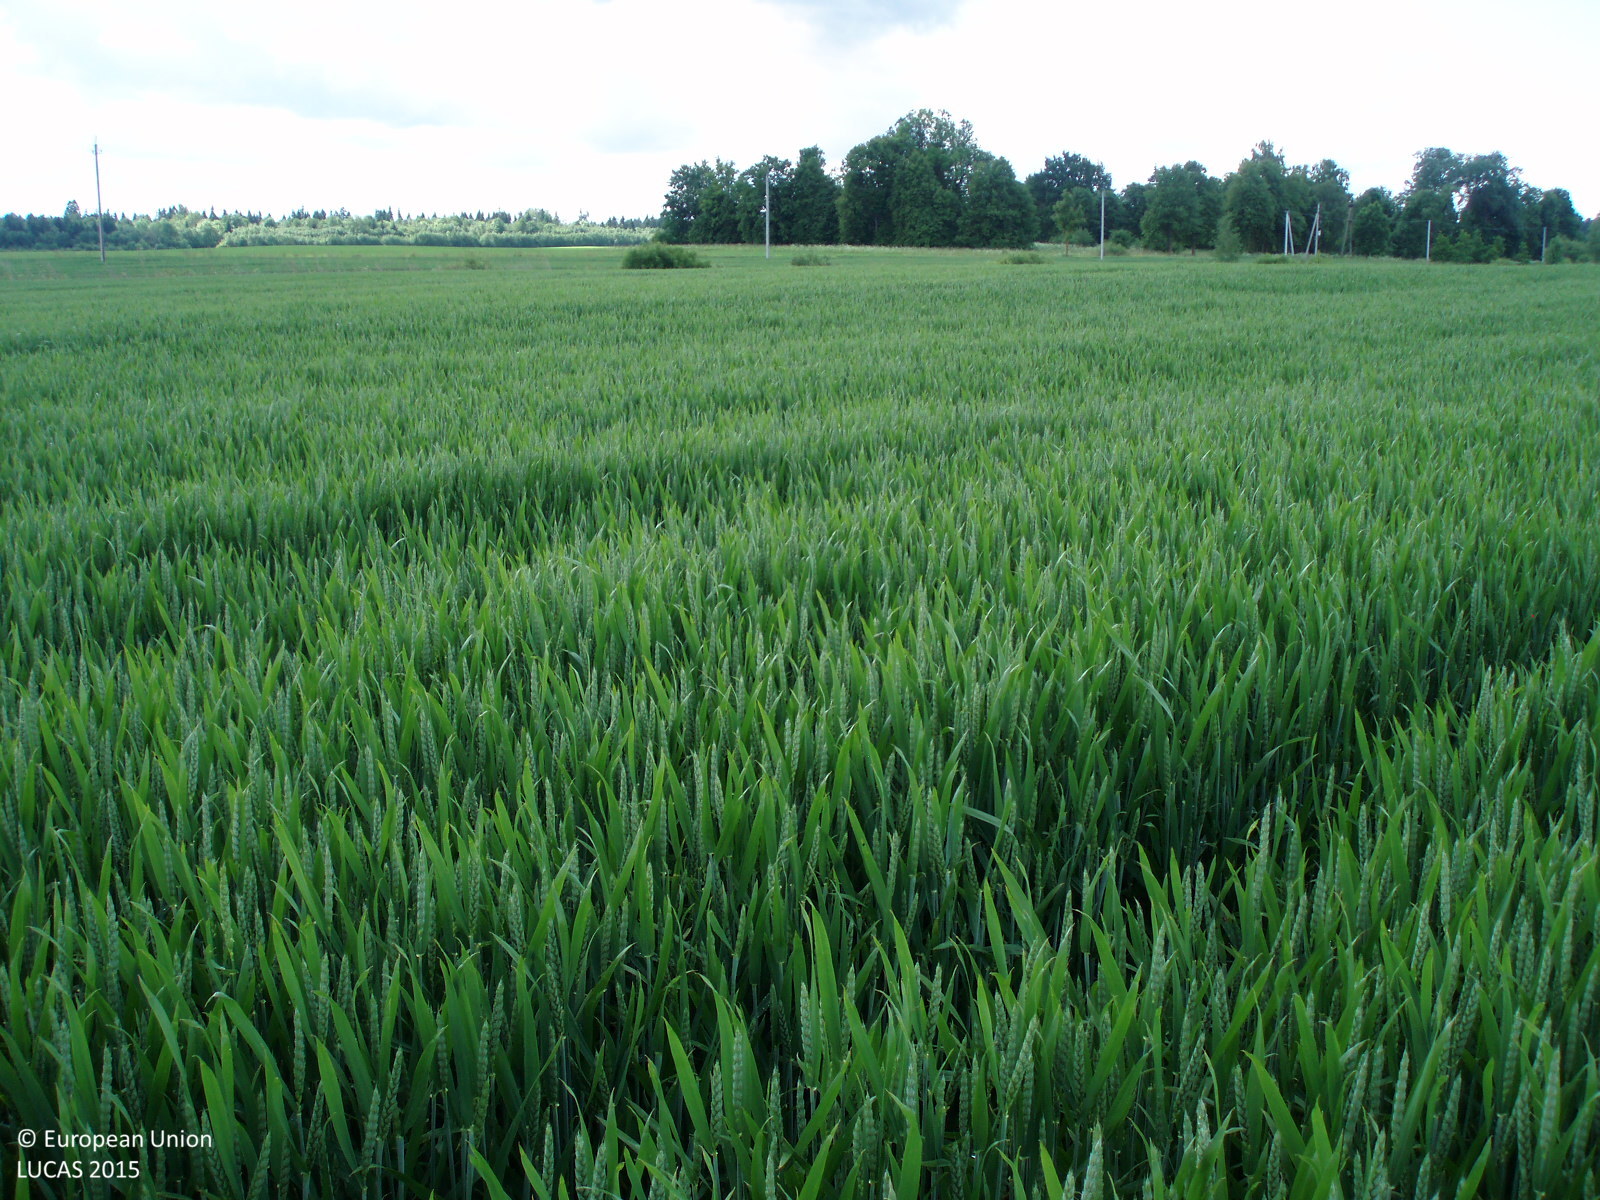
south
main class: Cropland
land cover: Common wheat
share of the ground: > 75 %
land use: Agriculture (excluding fallow land and kitchen gardens)
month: June
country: LT
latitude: 56.2972
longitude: 23.2736
